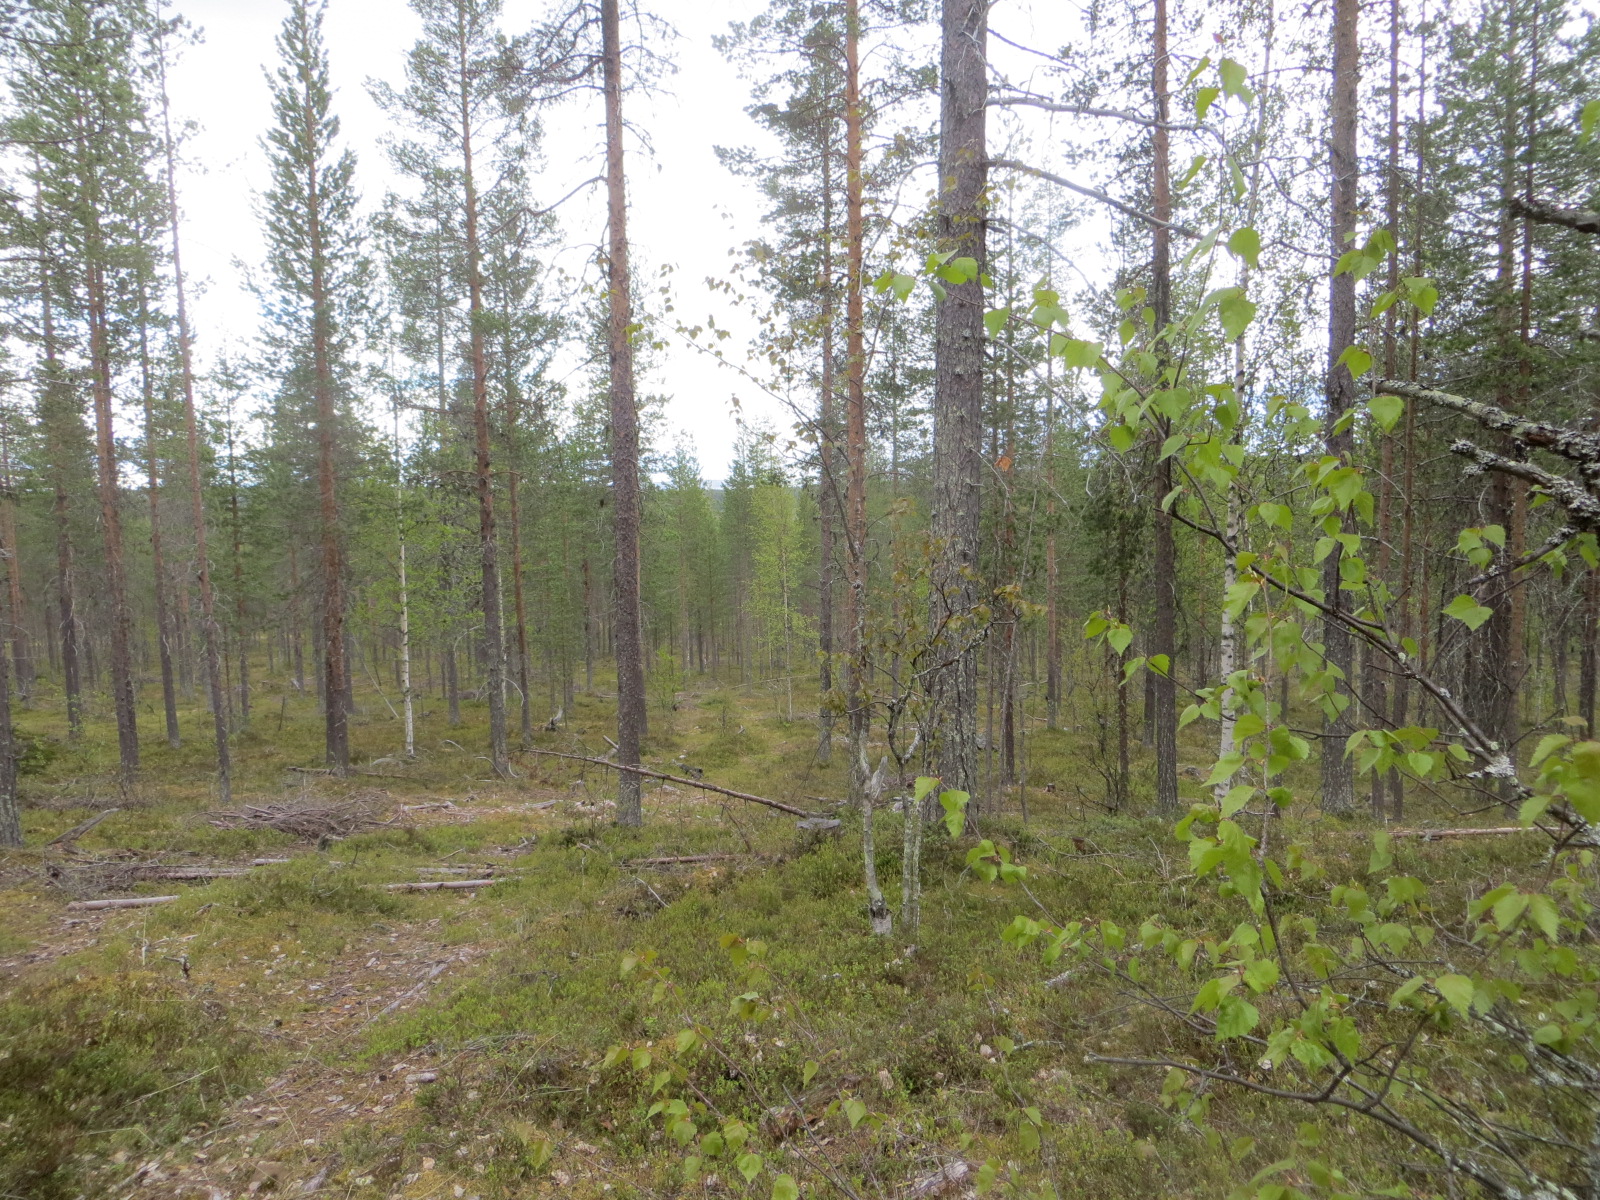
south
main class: Woodland
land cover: Pine dominated coniferous woodland
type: boreal forest
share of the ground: 50 - 75 %
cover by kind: coniferous forest trees 65 %, shrubs 15 %, broadleaved forest trees 10 %, herbaceous plants 5 %, lichens and mosses 5 %
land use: Forestry
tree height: > 5 m
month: June
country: FI
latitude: 67.5705
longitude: 25.7657
